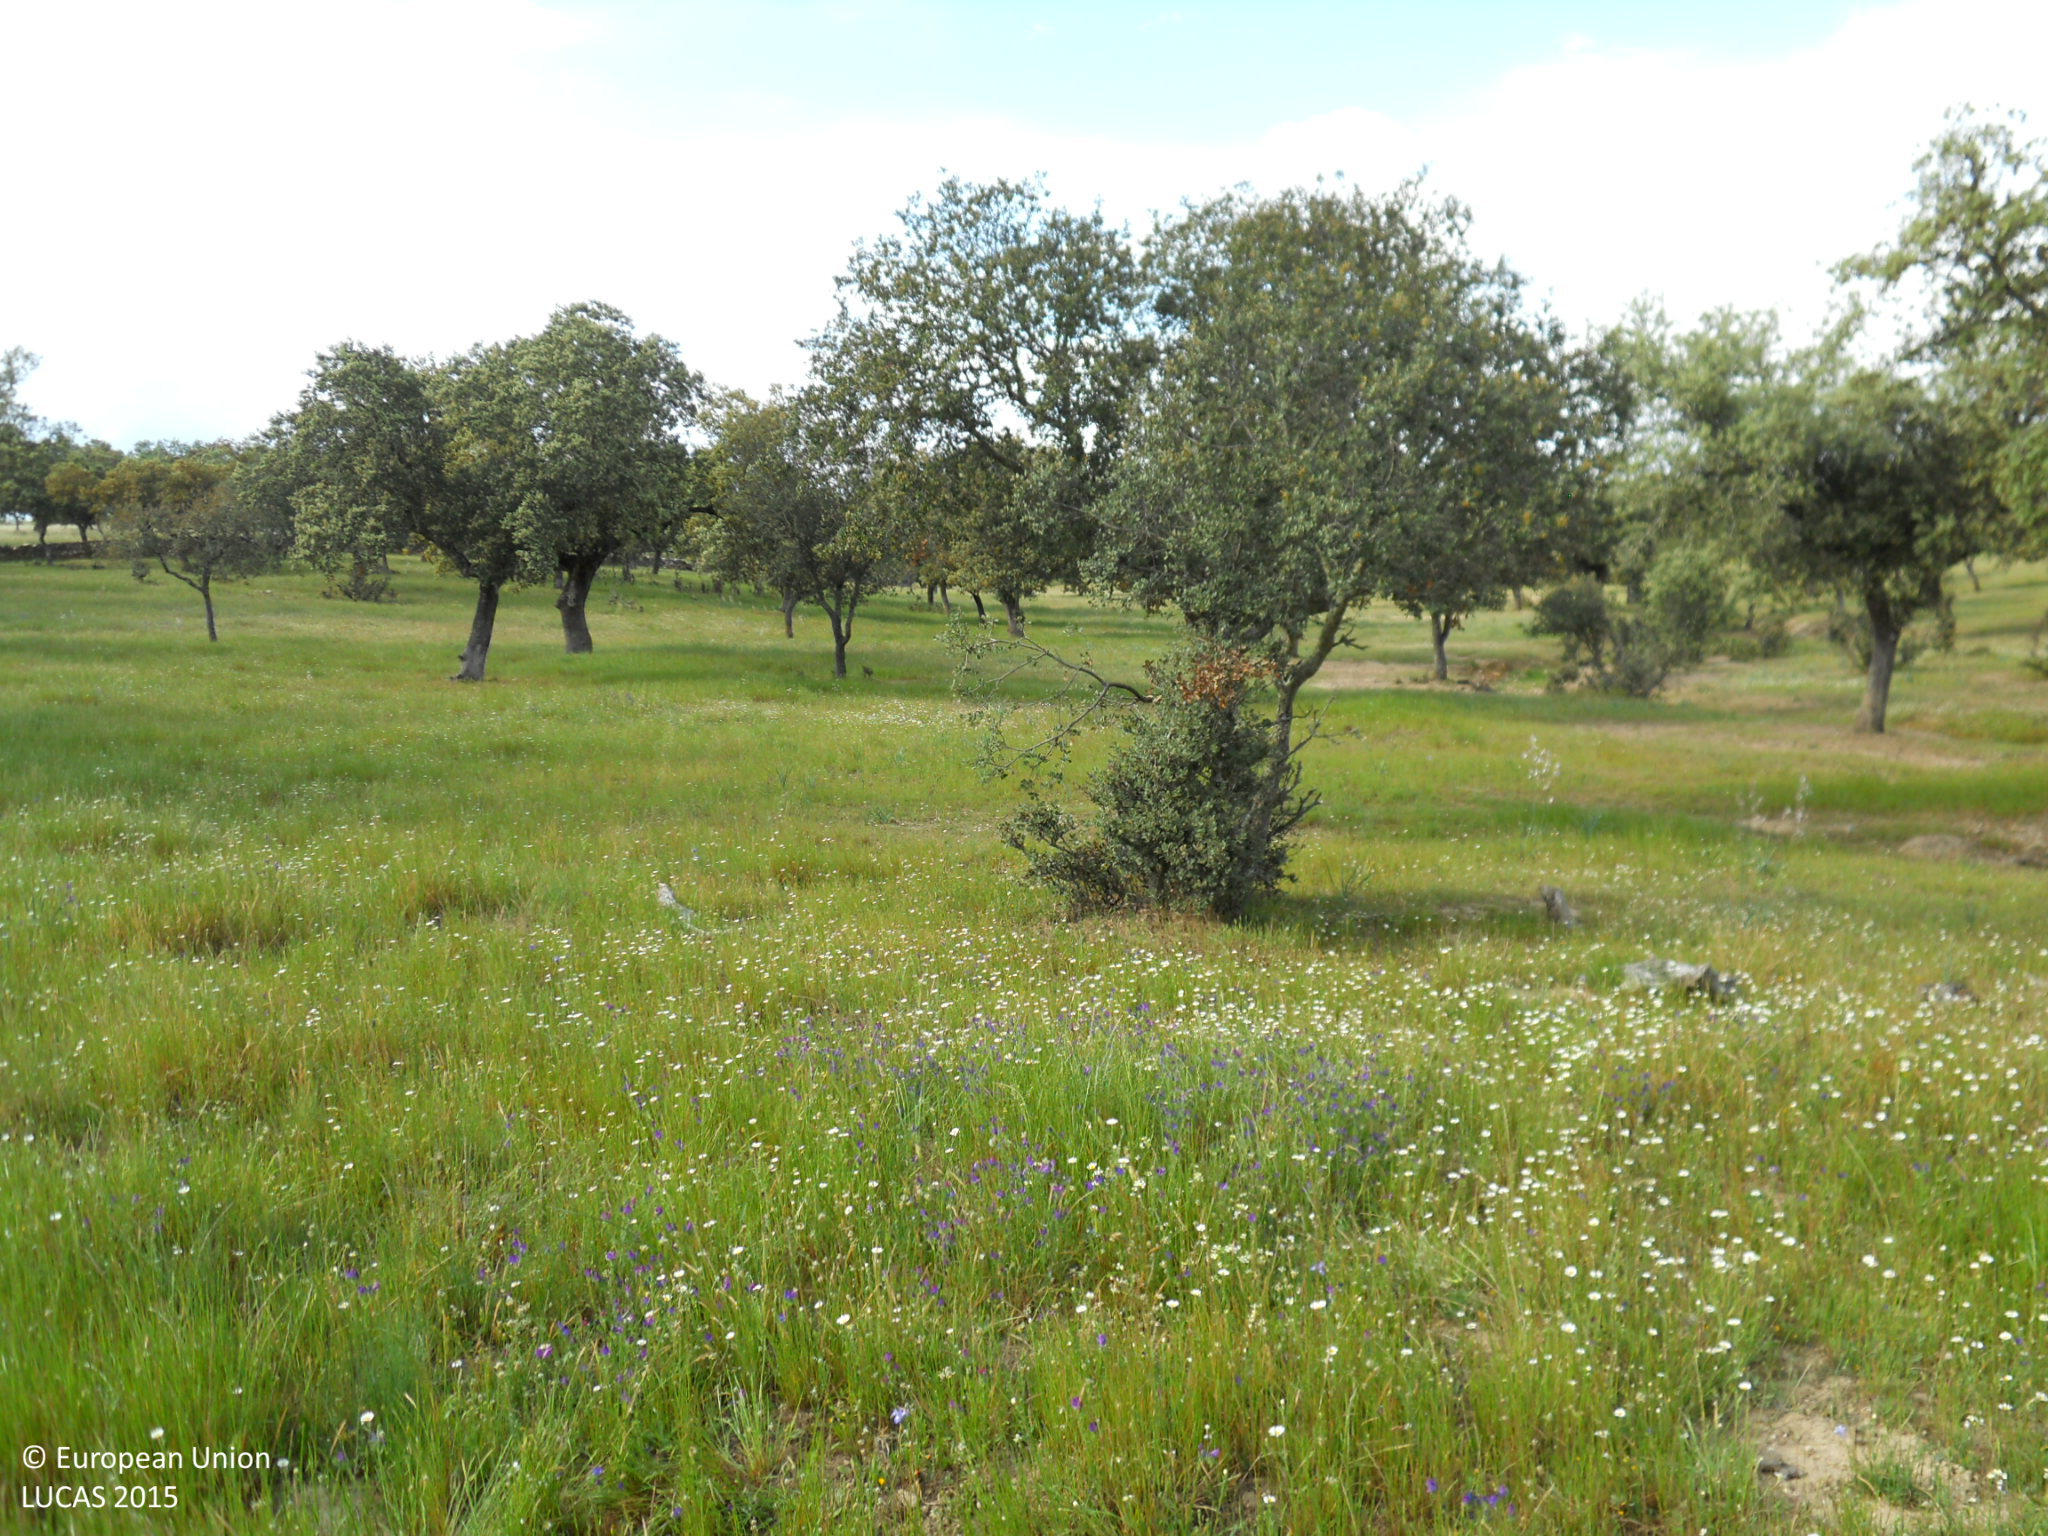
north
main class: Woodland
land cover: Broadleaved woodland
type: broadleaved evergreen forest
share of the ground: 10 - 25 %
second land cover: Grassland without tree/shrub cover
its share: > 75 %
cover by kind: herbaceous plants 65 %, broadleaved forest trees 35 %
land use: Forestry
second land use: Agriculture (excluding fallow land and kitchen gardens)
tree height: > 5 m
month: April
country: ES
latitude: 39.2857
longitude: -6.8030
